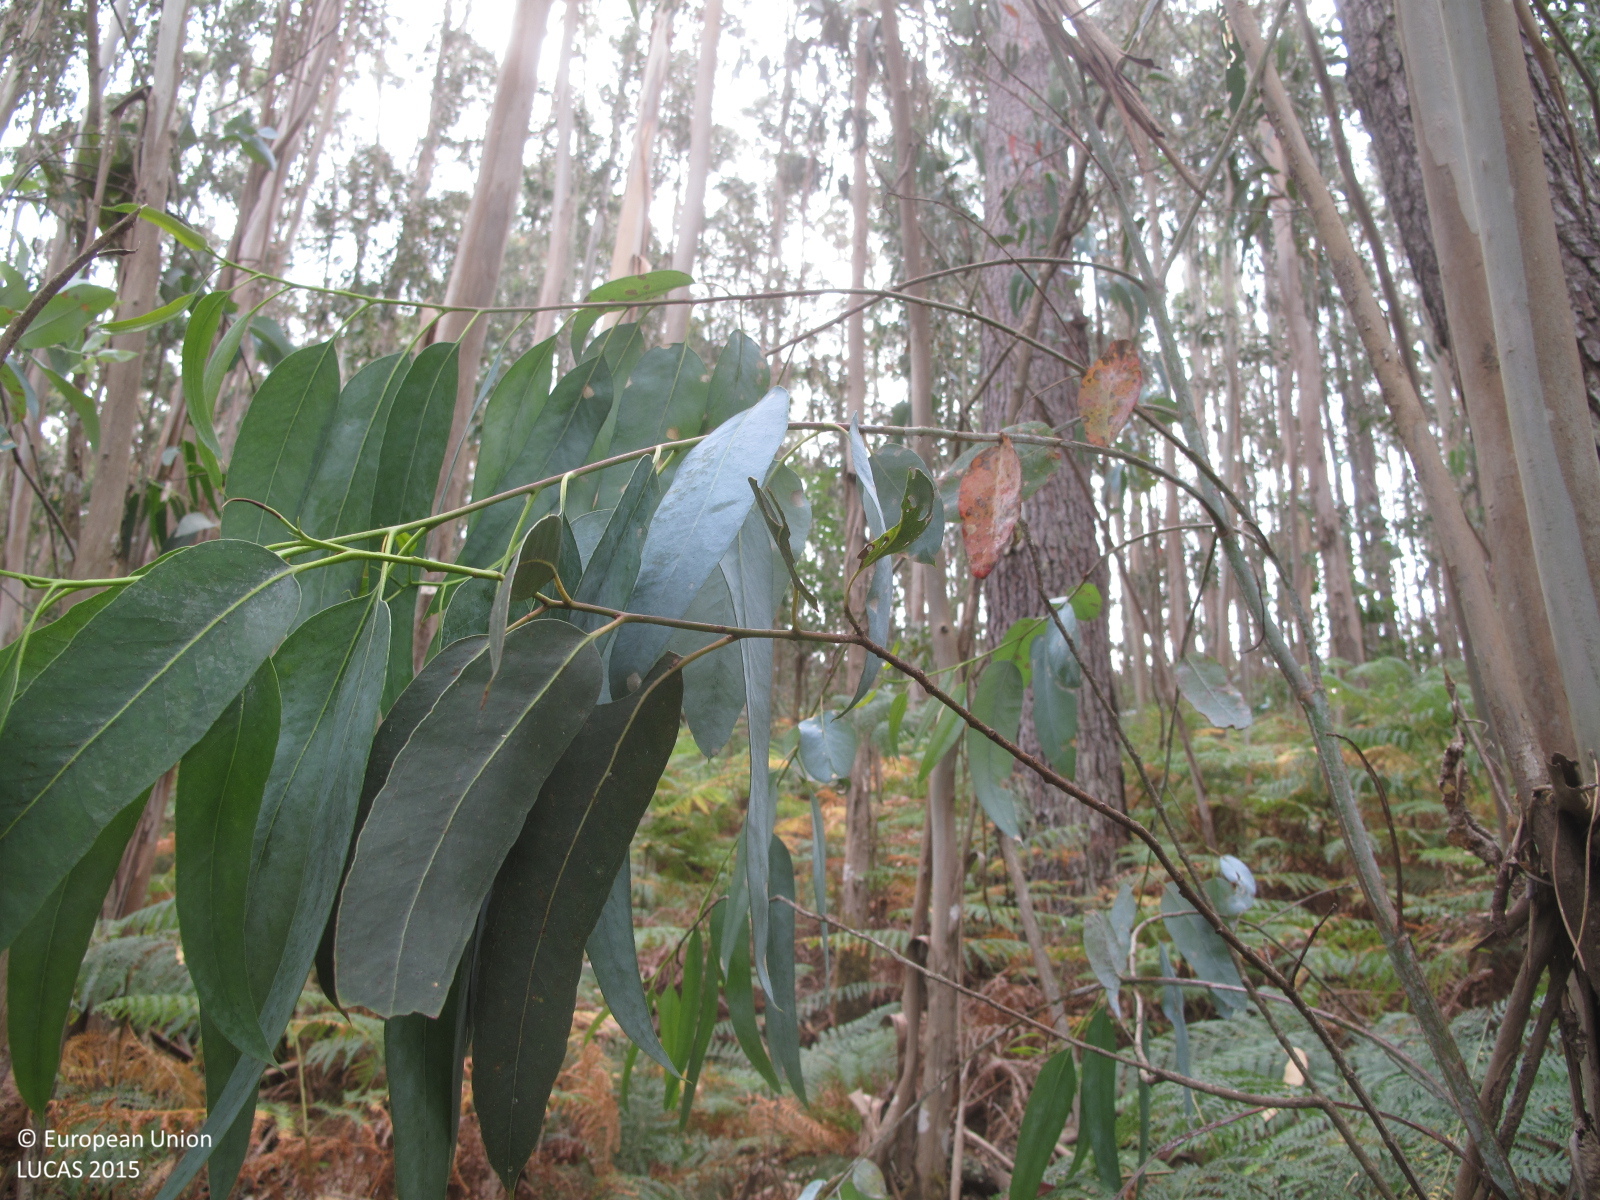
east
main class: Woodland
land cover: Other mixed woodland
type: exotic forest
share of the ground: 50 - 75 %
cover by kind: broadleaved forest trees 40 %, herbaceous plants 30 %, coniferous forest trees 20 %, shrubs 10 %
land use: Forestry
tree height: > 5 m
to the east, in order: Other mixed woodland; Tracks; Other mixed woodland; Broadleaved woodland
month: July
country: ES
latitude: 43.2946
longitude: -8.6135
